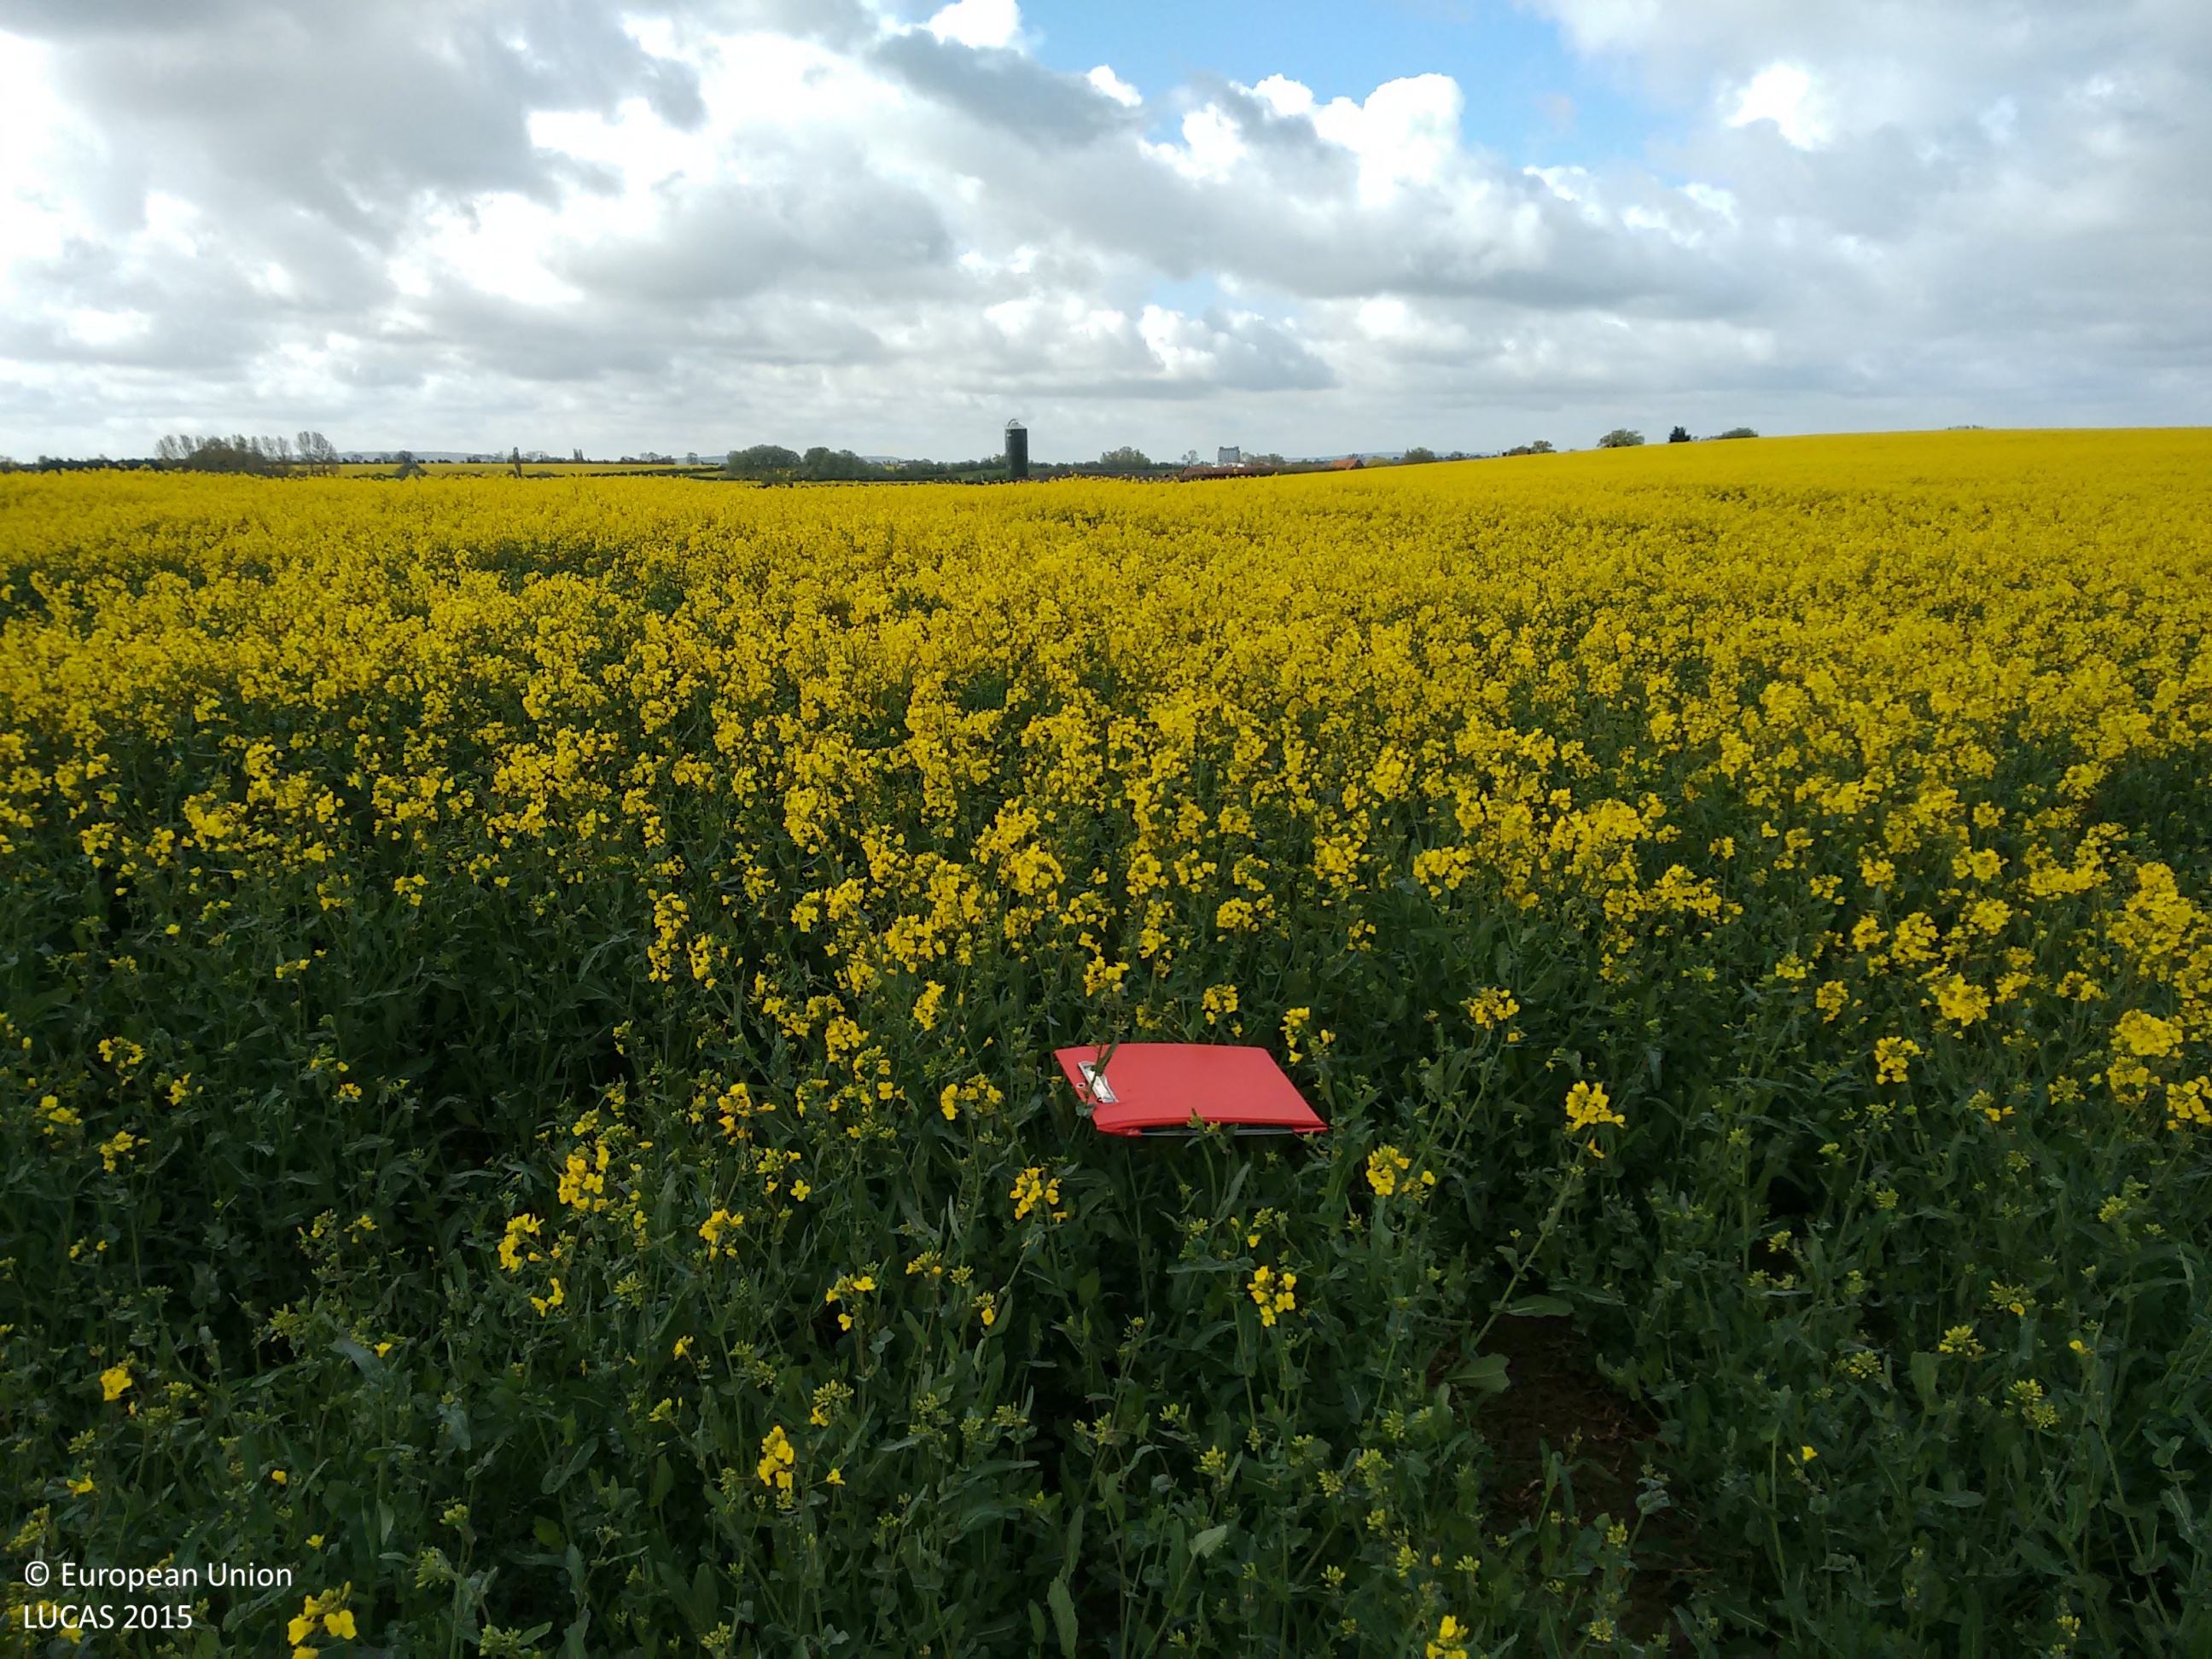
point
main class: Cropland
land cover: Rape and turnip rape
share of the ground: > 75 %
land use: Agriculture (excluding fallow land and kitchen gardens)
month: April
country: GB
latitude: 51.8470
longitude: -0.7985
